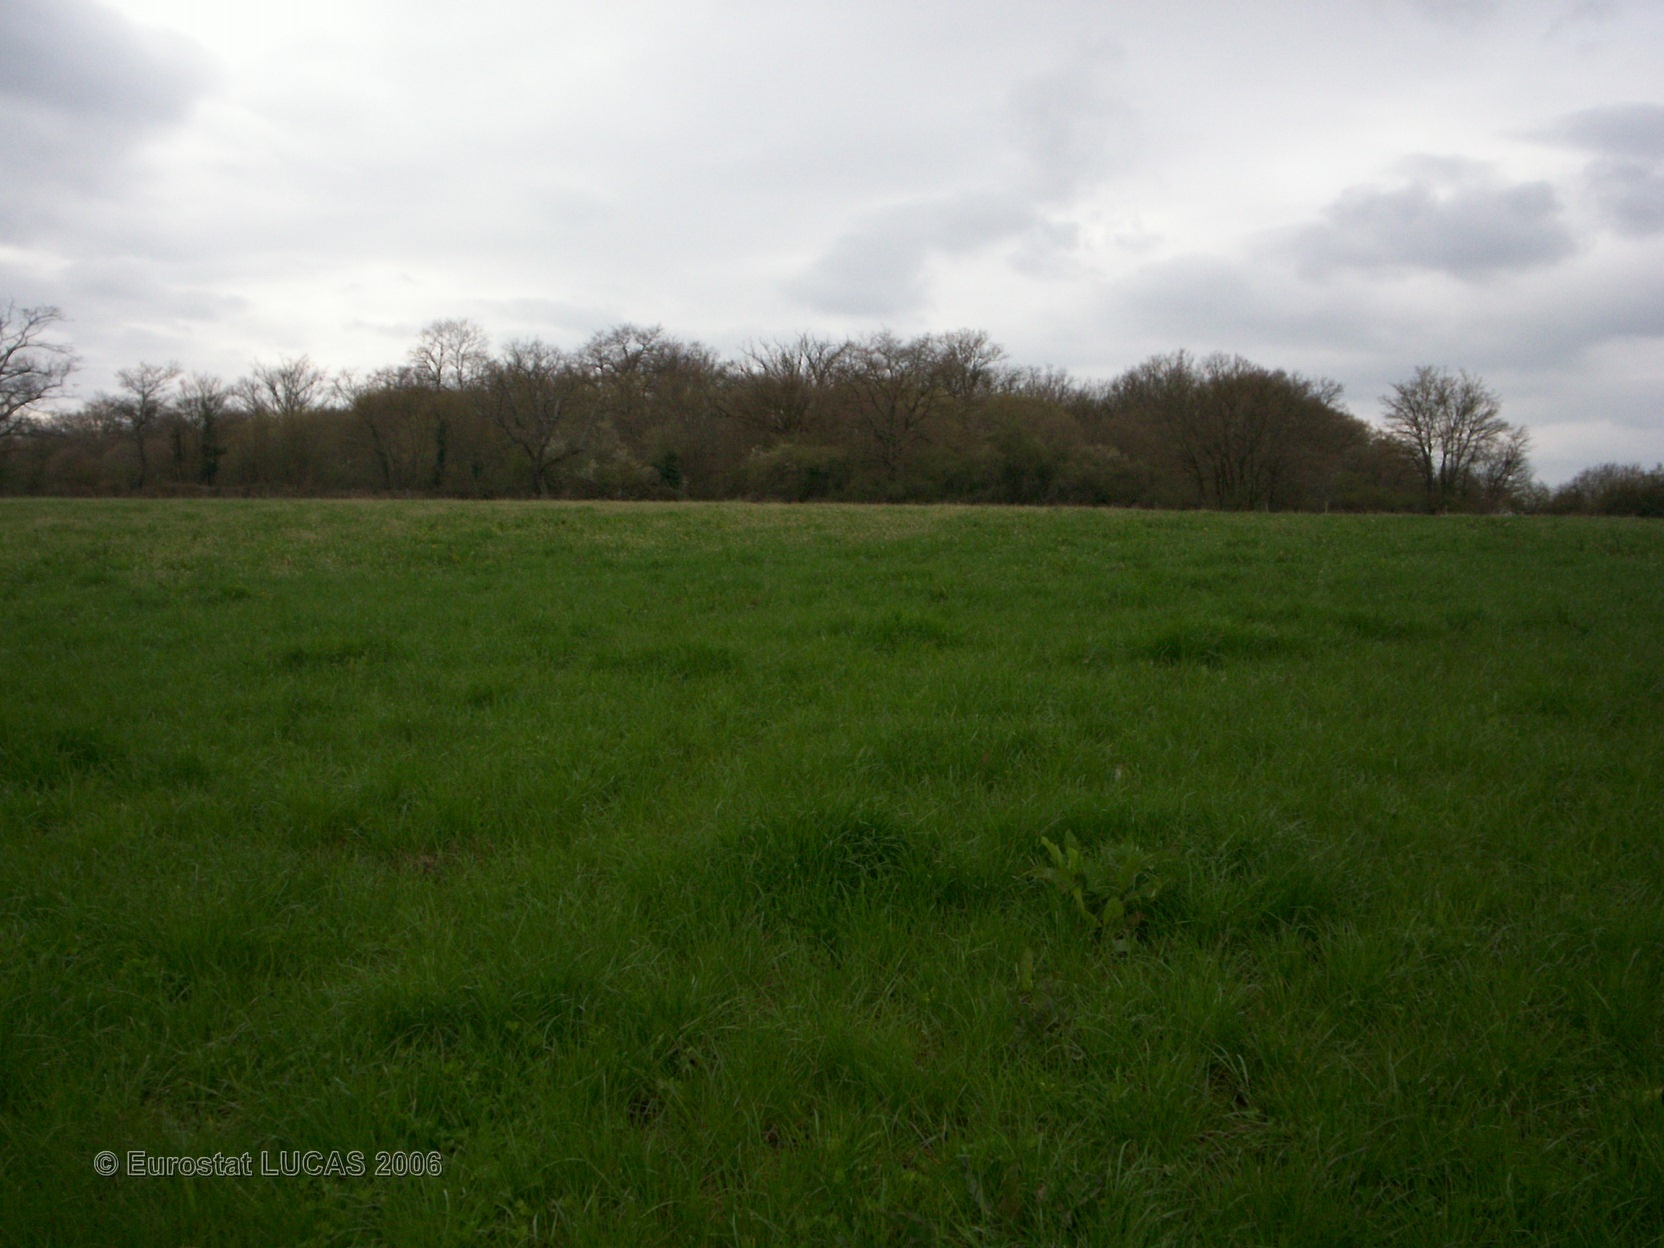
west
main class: Grassland
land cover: Grassland without tree/shrub cover
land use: Agriculture (excluding fallow land and kitchen gardens)
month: April
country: FR
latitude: 46.7197
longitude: 3.0233
